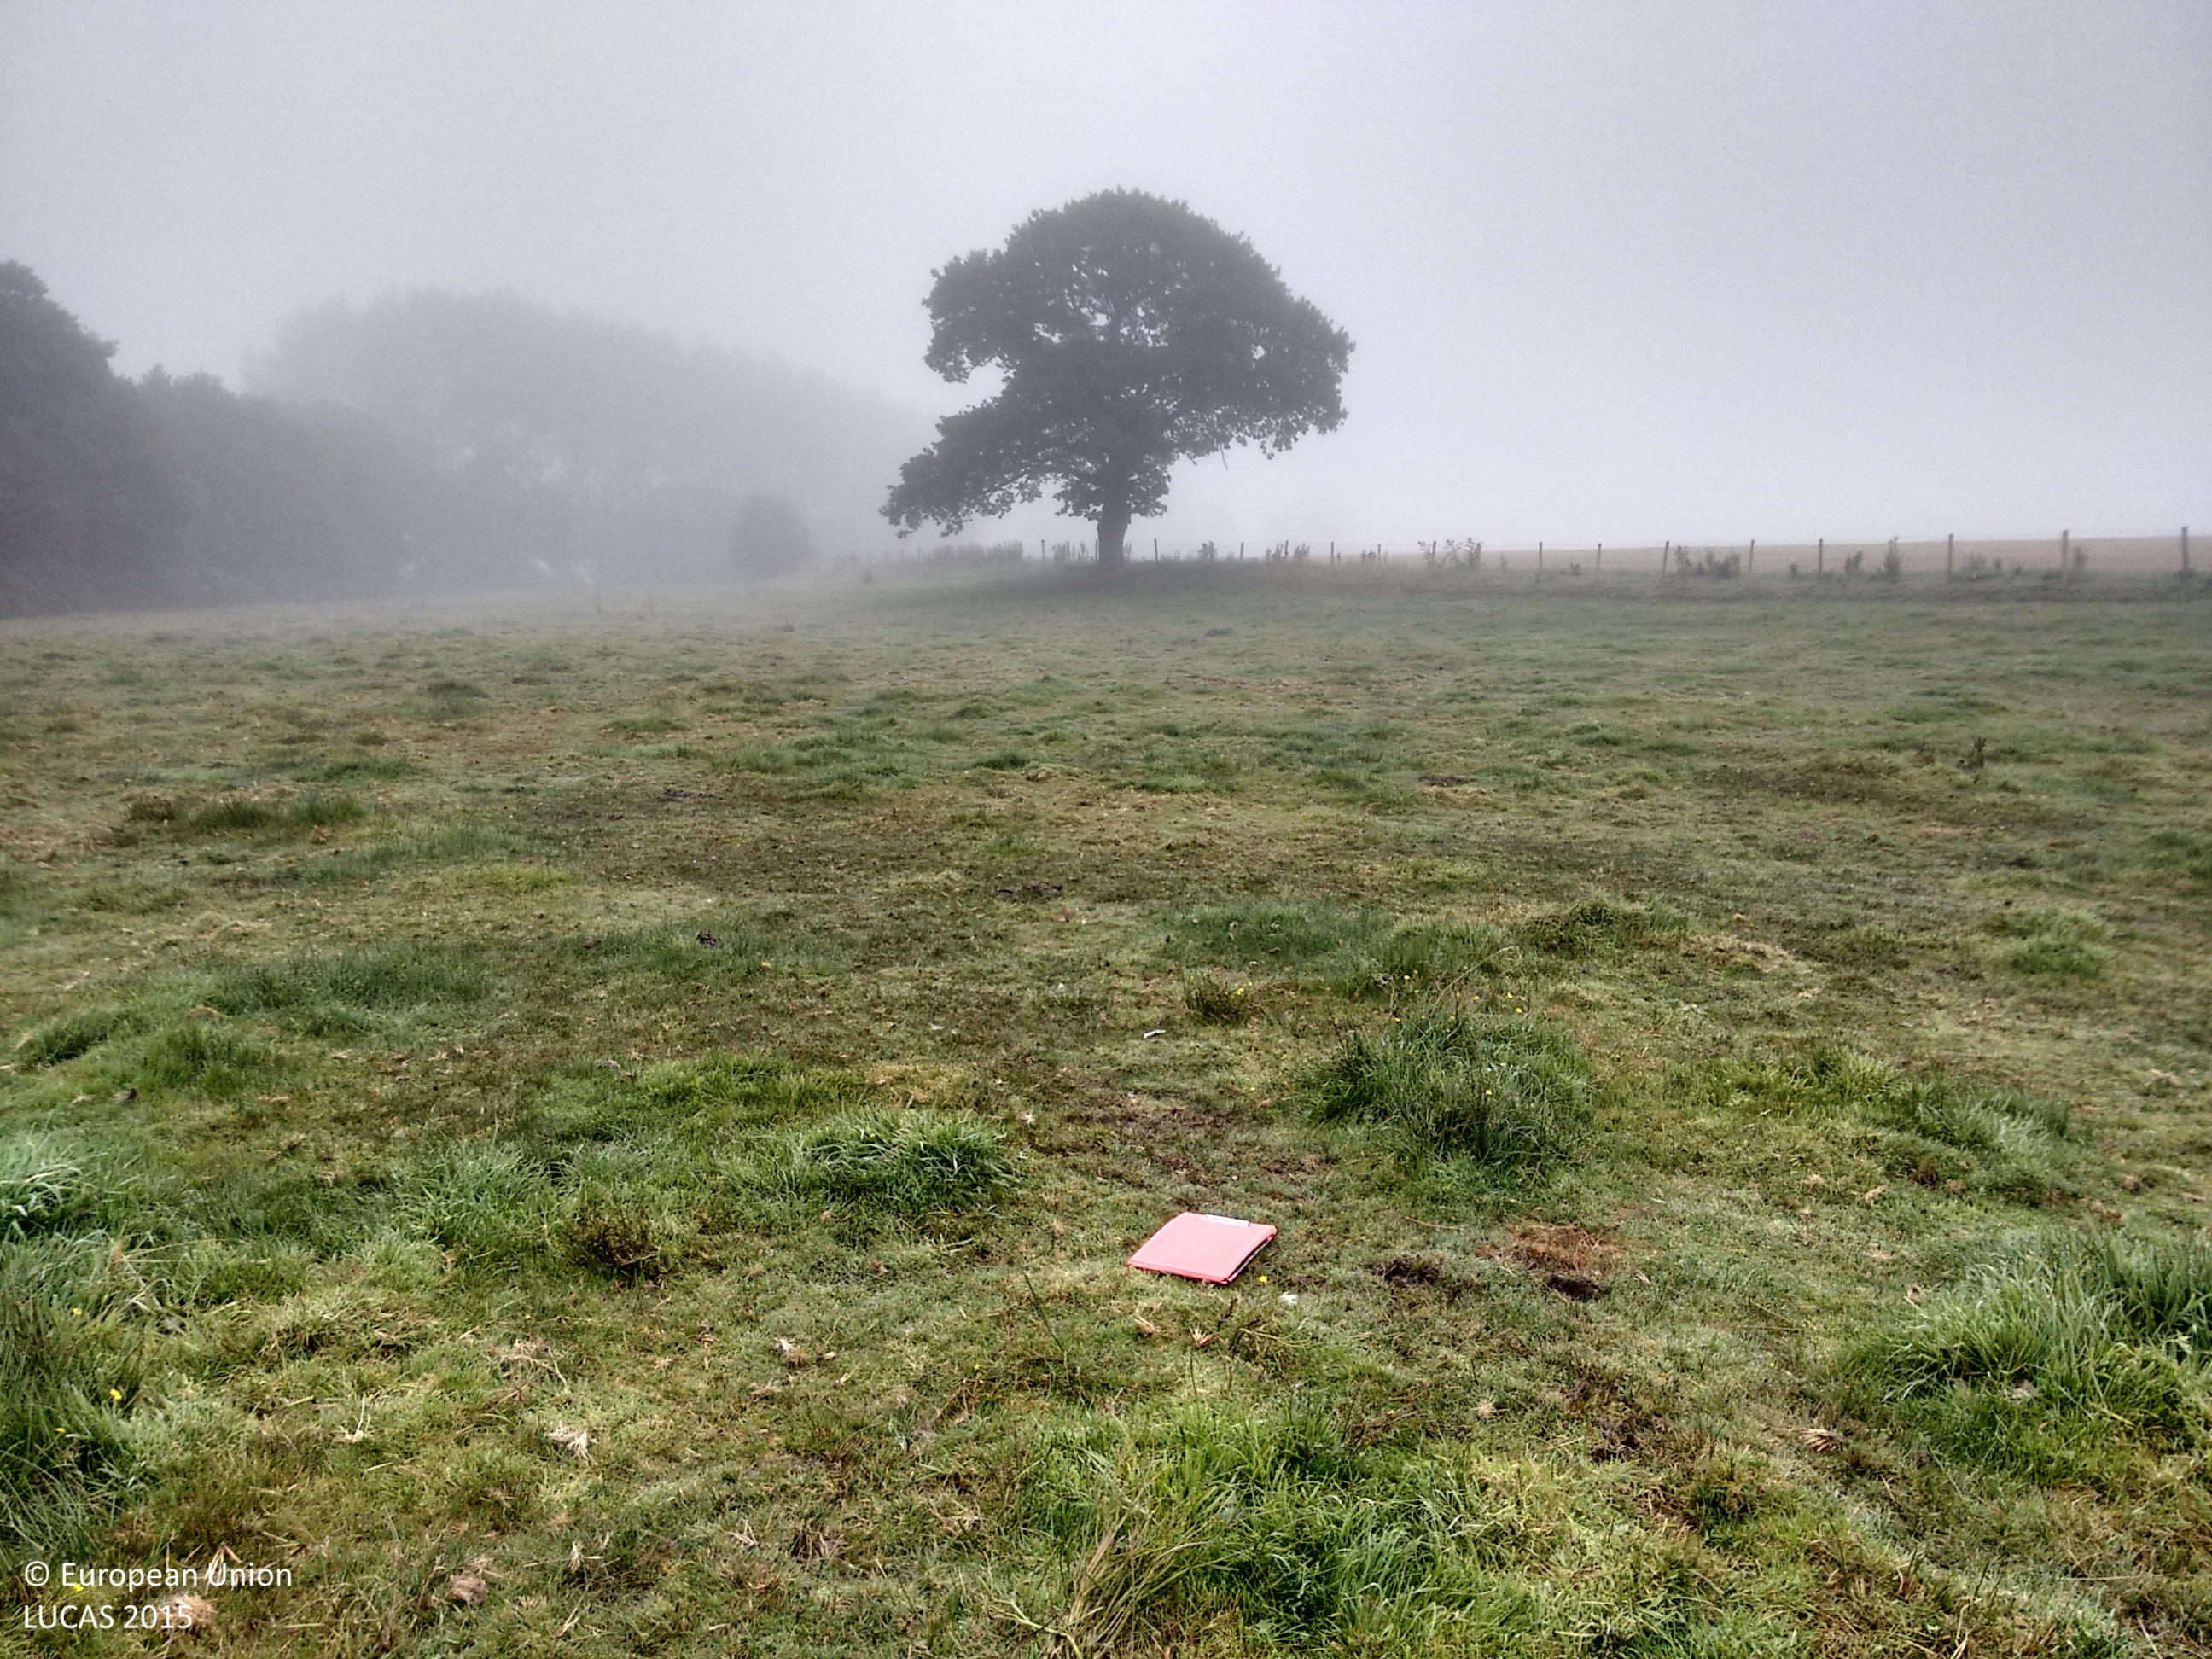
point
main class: Grassland
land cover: Grassland without tree/shrub cover
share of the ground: > 75 %
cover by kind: herbaceous plants 100 %
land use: Agriculture (excluding fallow land and kitchen gardens)
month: September
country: GB
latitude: 52.8135
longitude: -2.9371
